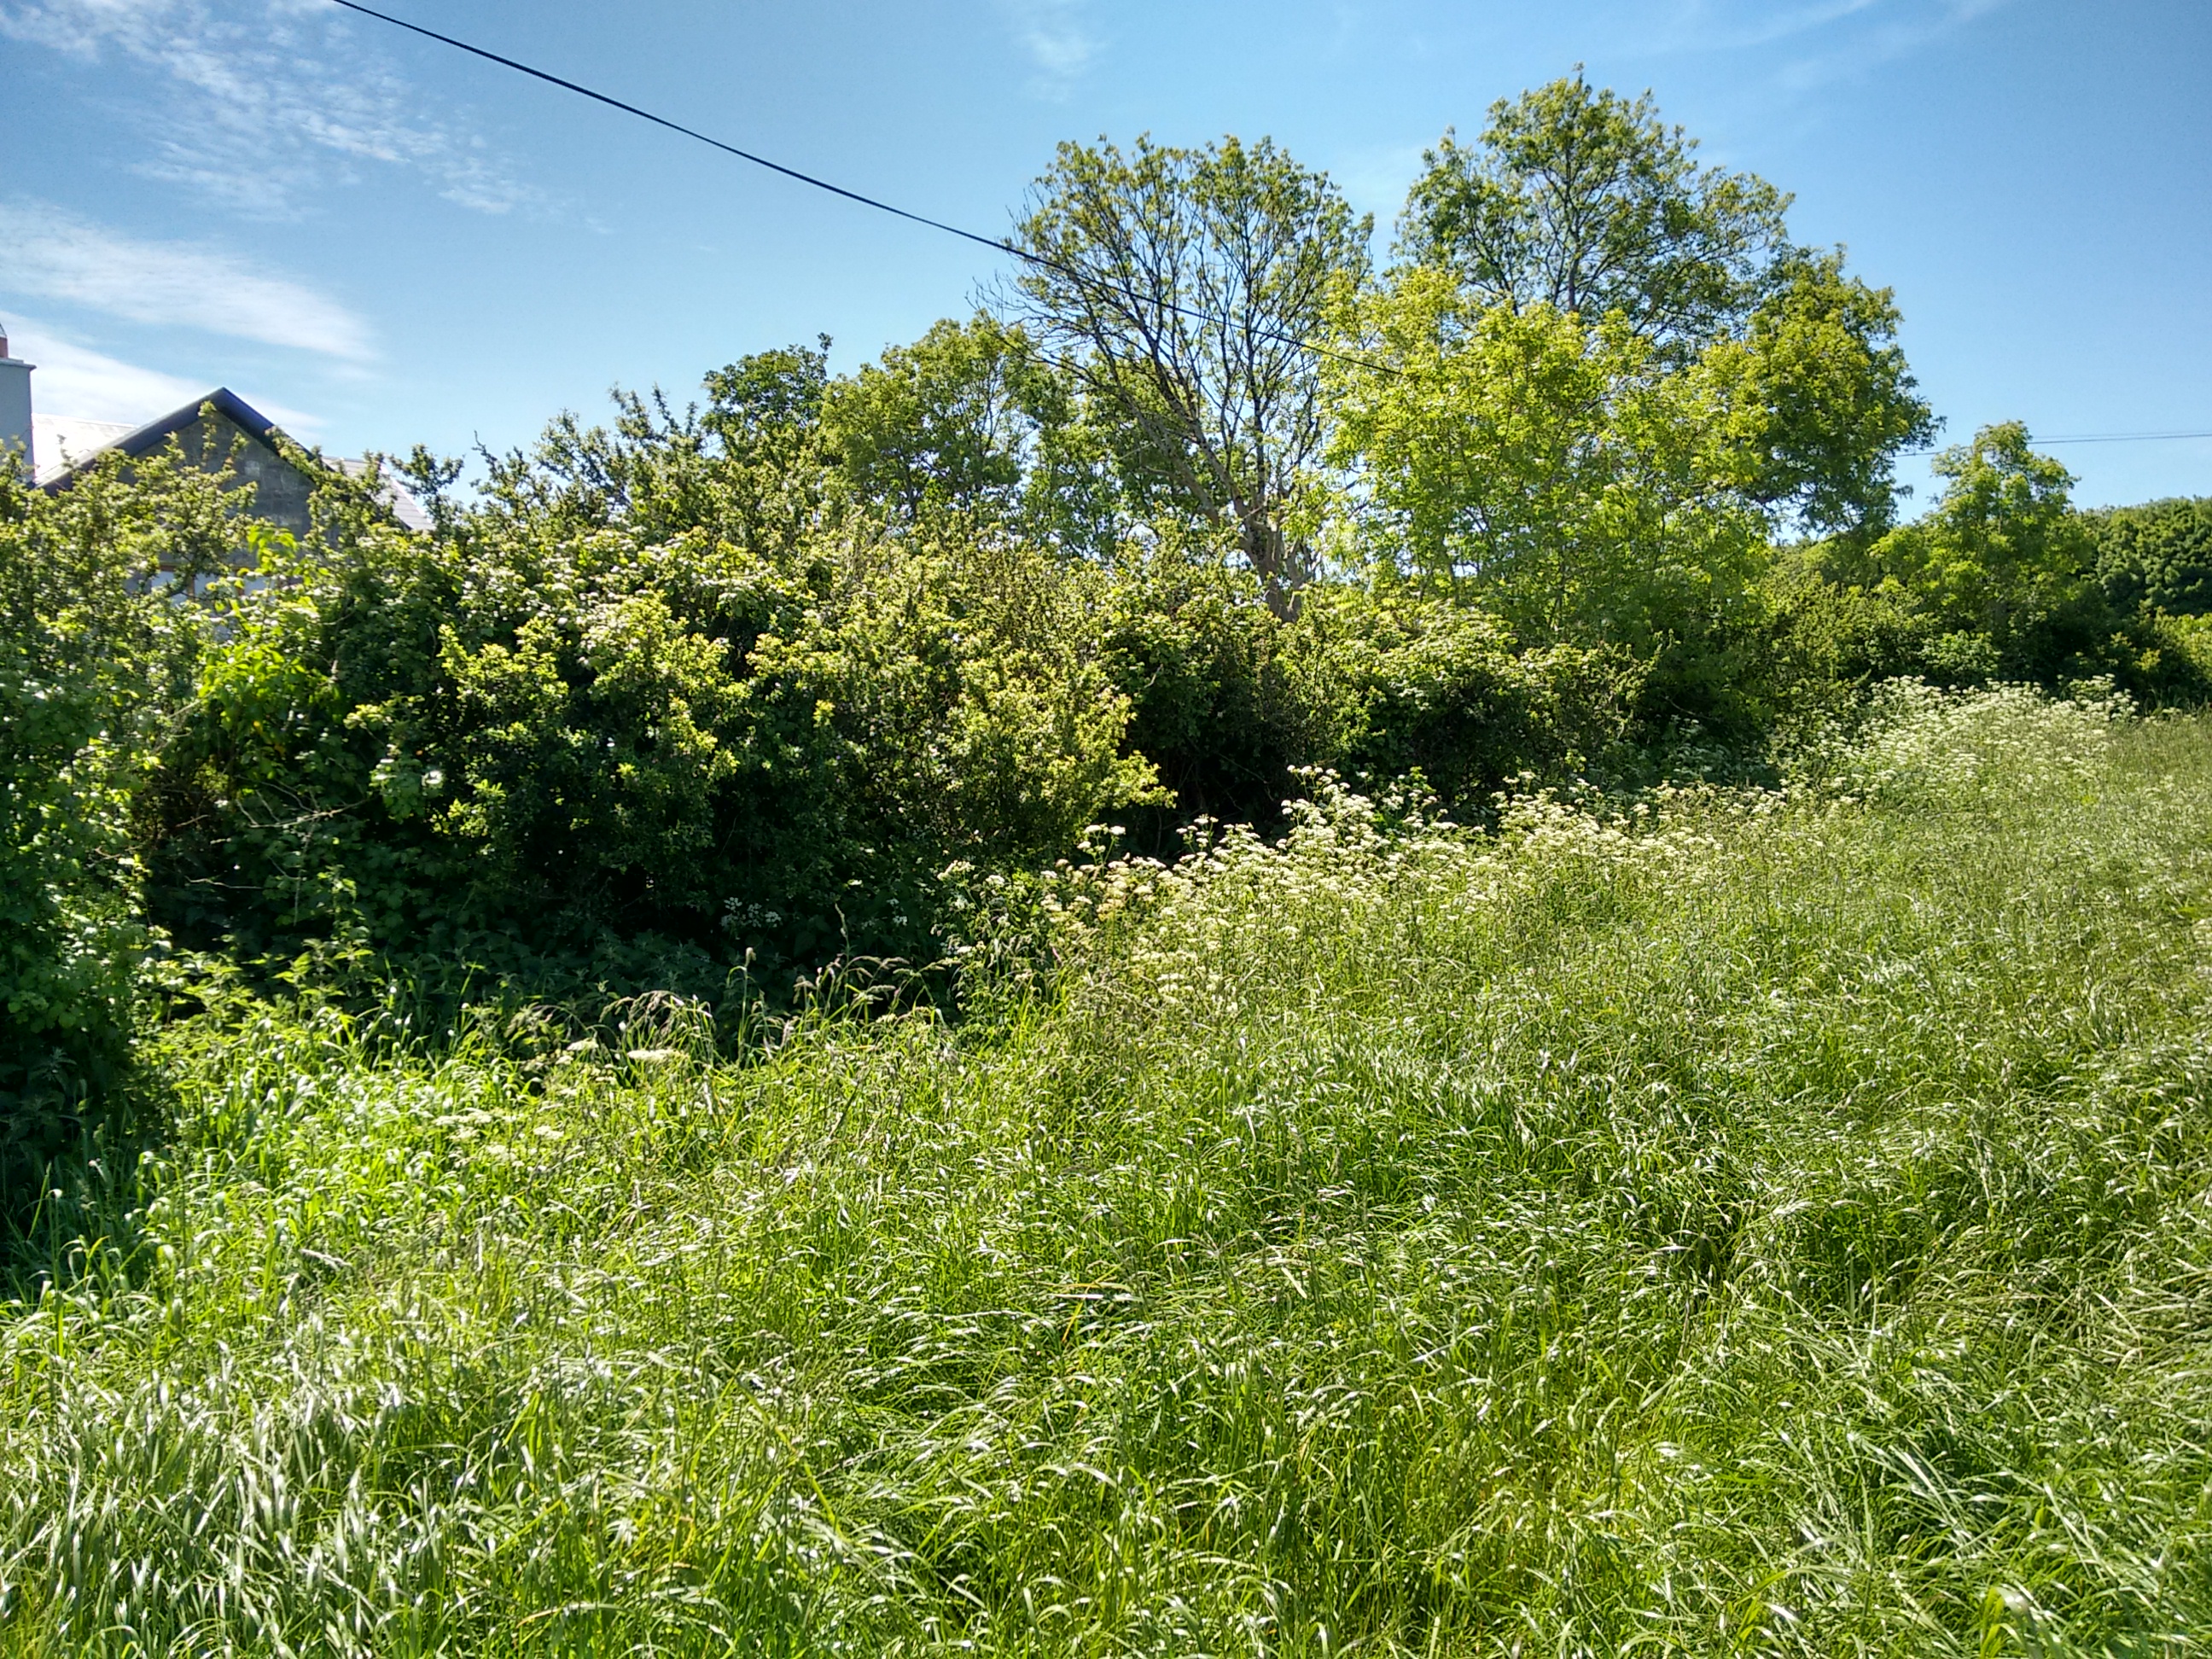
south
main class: Grassland
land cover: Grassland without tree/shrub cover
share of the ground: > 75 %
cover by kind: herbaceous plants 100 %
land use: Agriculture (excluding fallow land and kitchen gardens)
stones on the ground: < 10 %
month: June
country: IE
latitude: 53.2523
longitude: -8.9613
